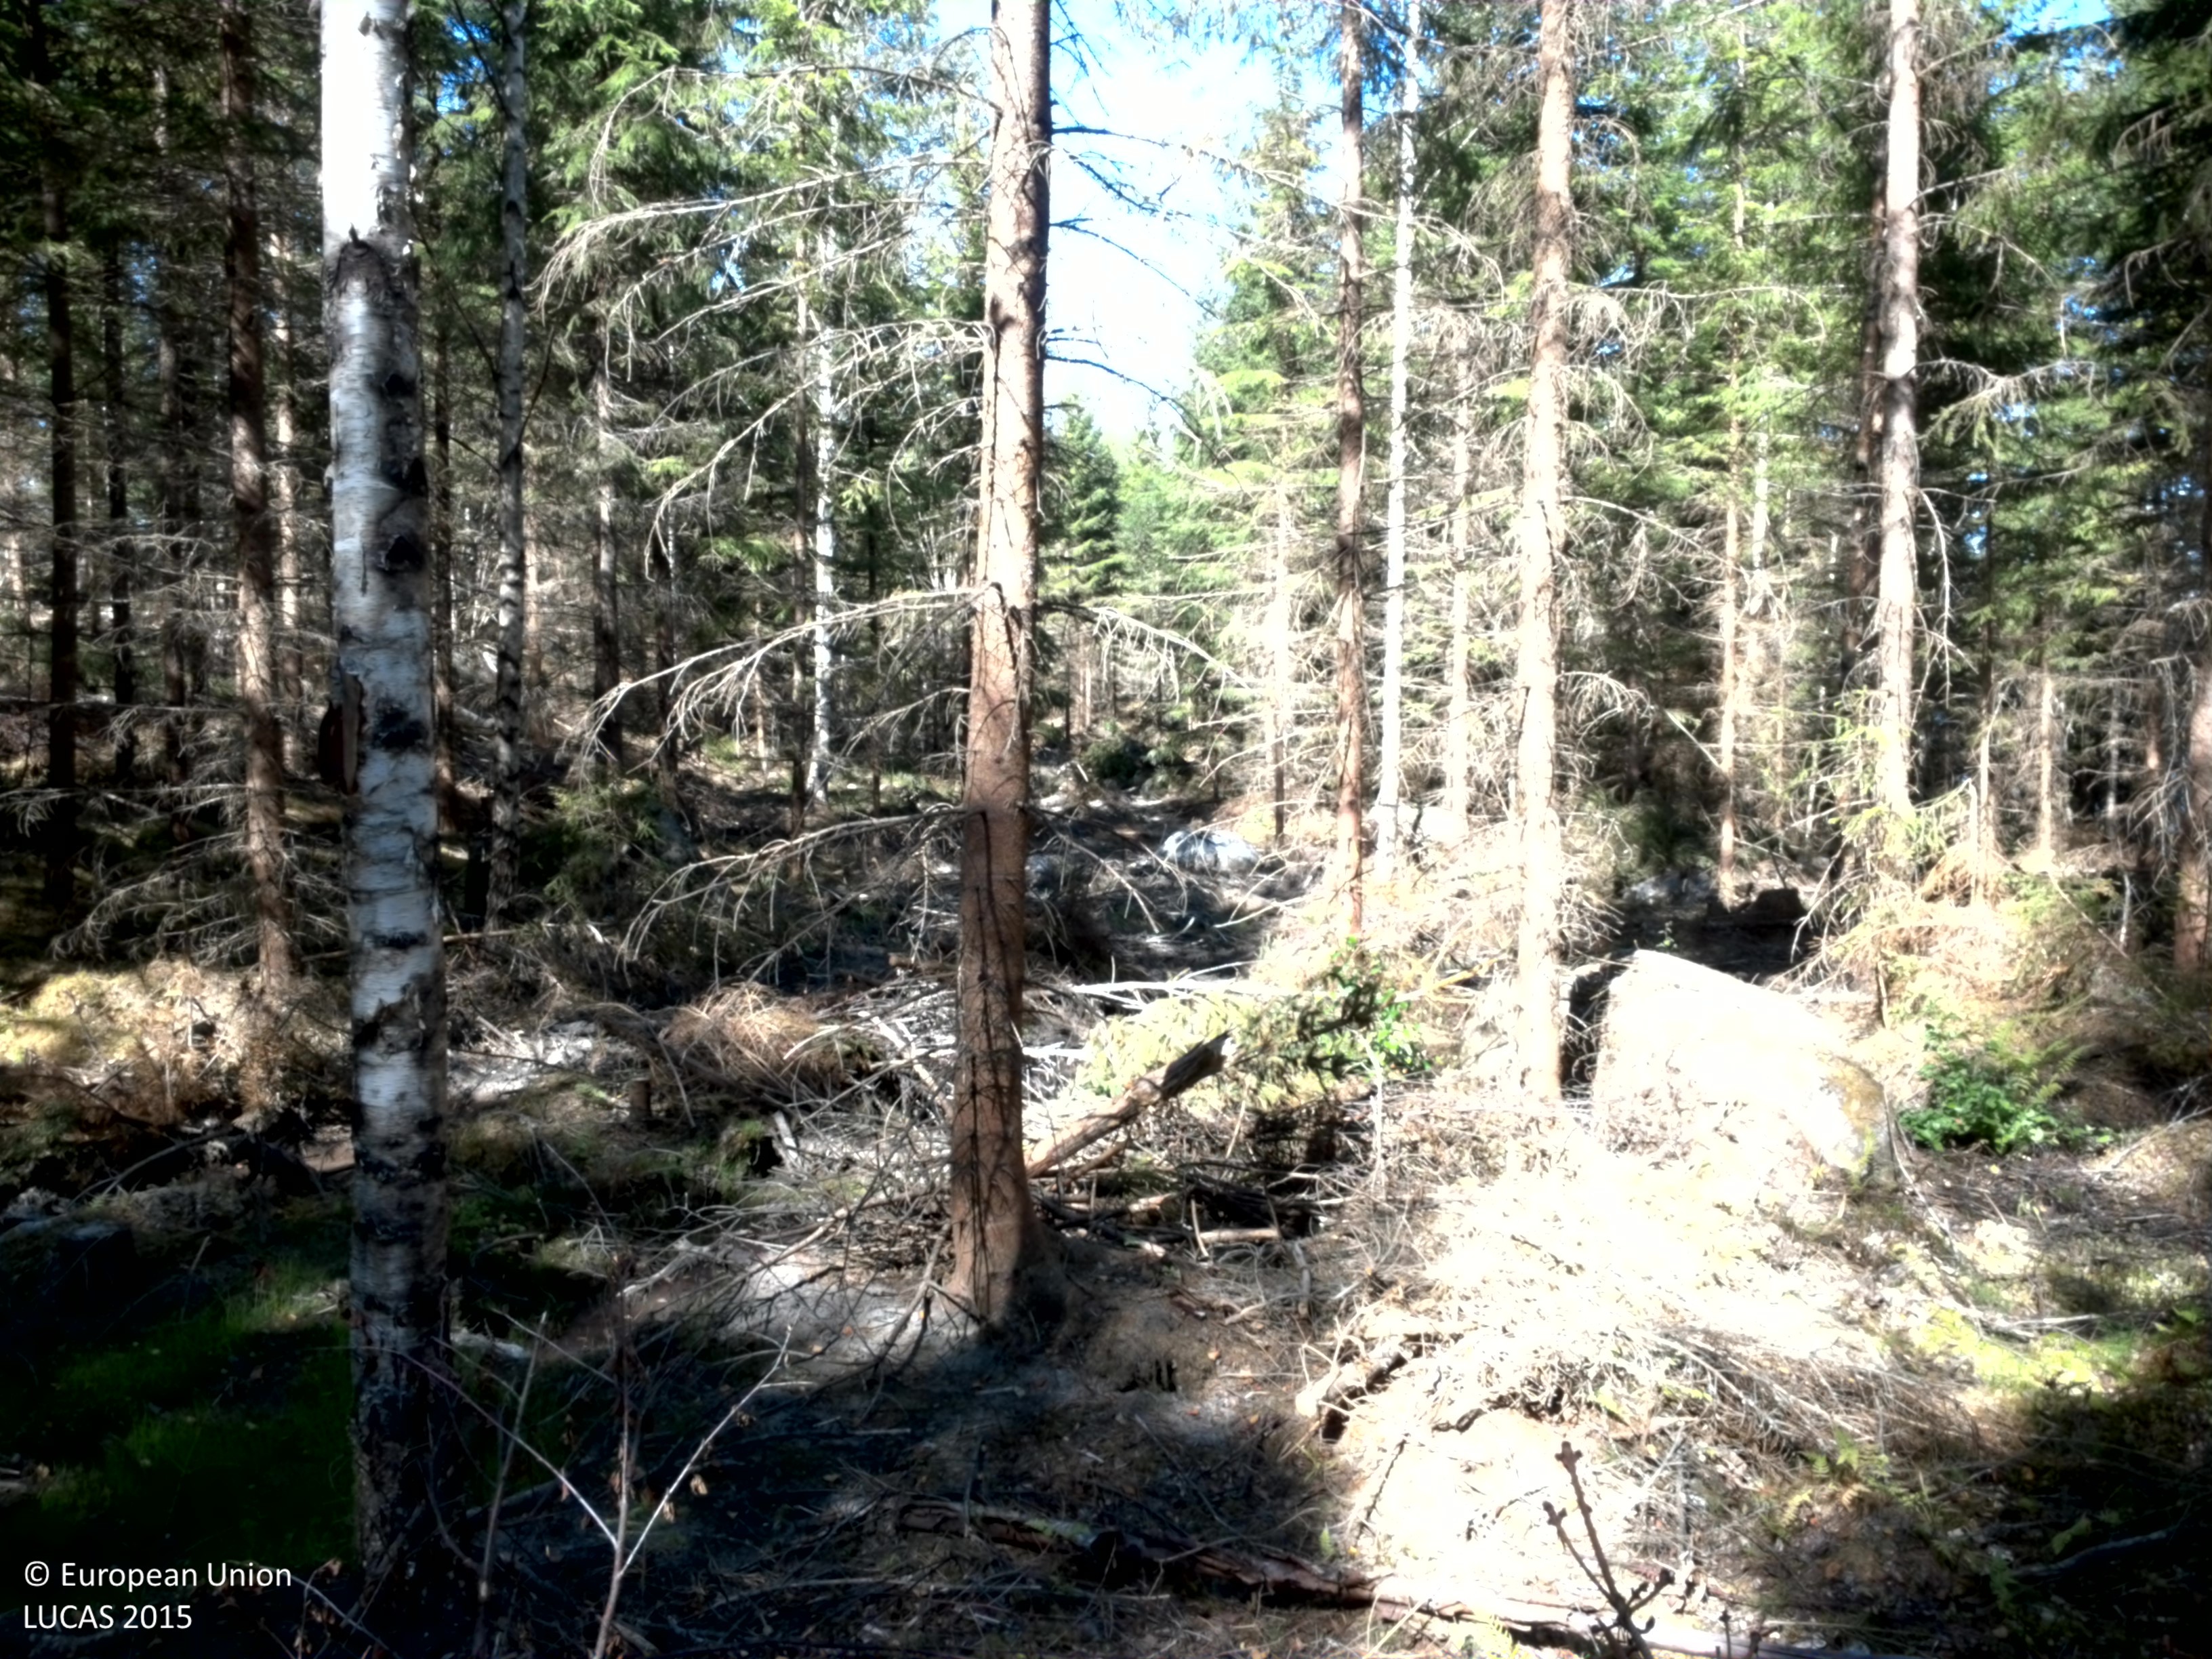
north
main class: Woodland
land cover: Spruce dominated mixed woodland
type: boreal forest
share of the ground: 50 - 75 %
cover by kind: coniferous forest trees 30 %, broadleaved forest trees 20 %, lichens and mosses 15 %, consolidated bare surface 10 %, shrubs 5 %
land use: Forestry
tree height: > 5 m
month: August
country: SE
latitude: 59.7415
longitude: 14.1360
